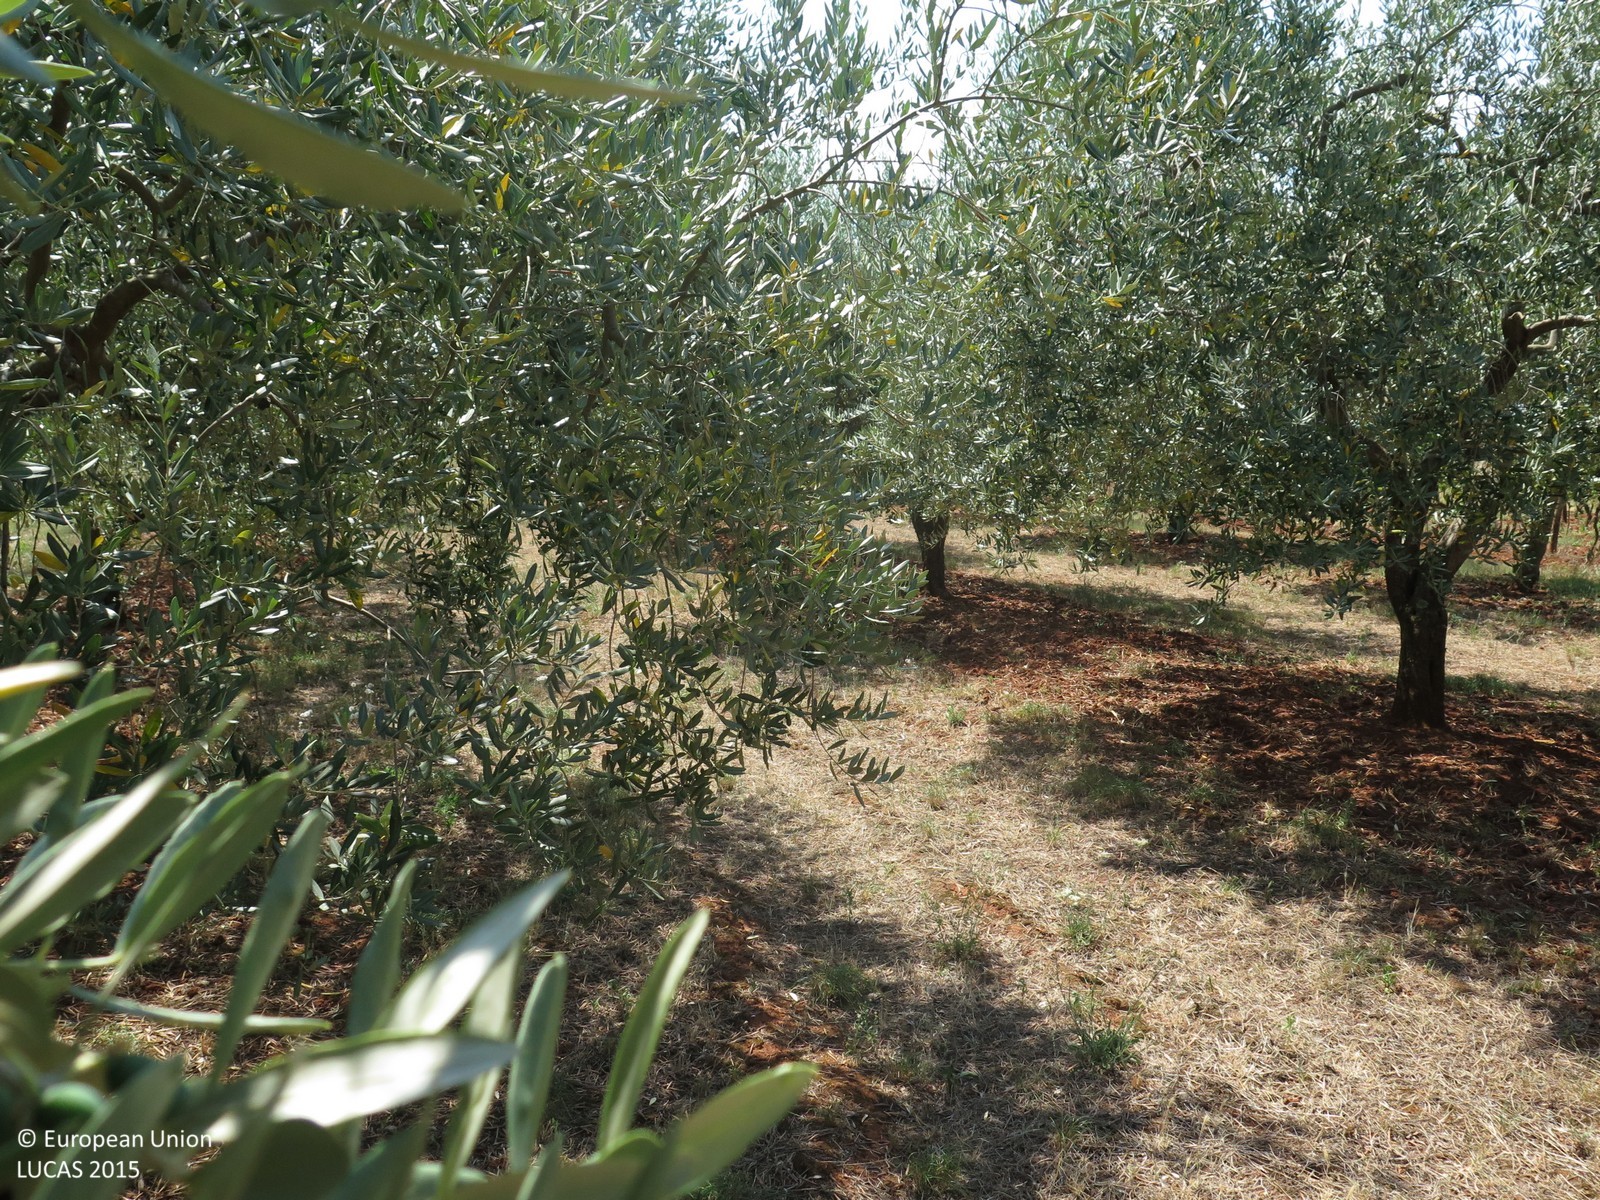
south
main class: Cropland
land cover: Olive groves
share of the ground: 50 - 75 %
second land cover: Grassland without tree/shrub cover
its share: > 75 %
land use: Agriculture (excluding fallow land and kitchen gardens)
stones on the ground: < 10 %
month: July
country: HR
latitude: 45.3140
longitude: 13.6814
